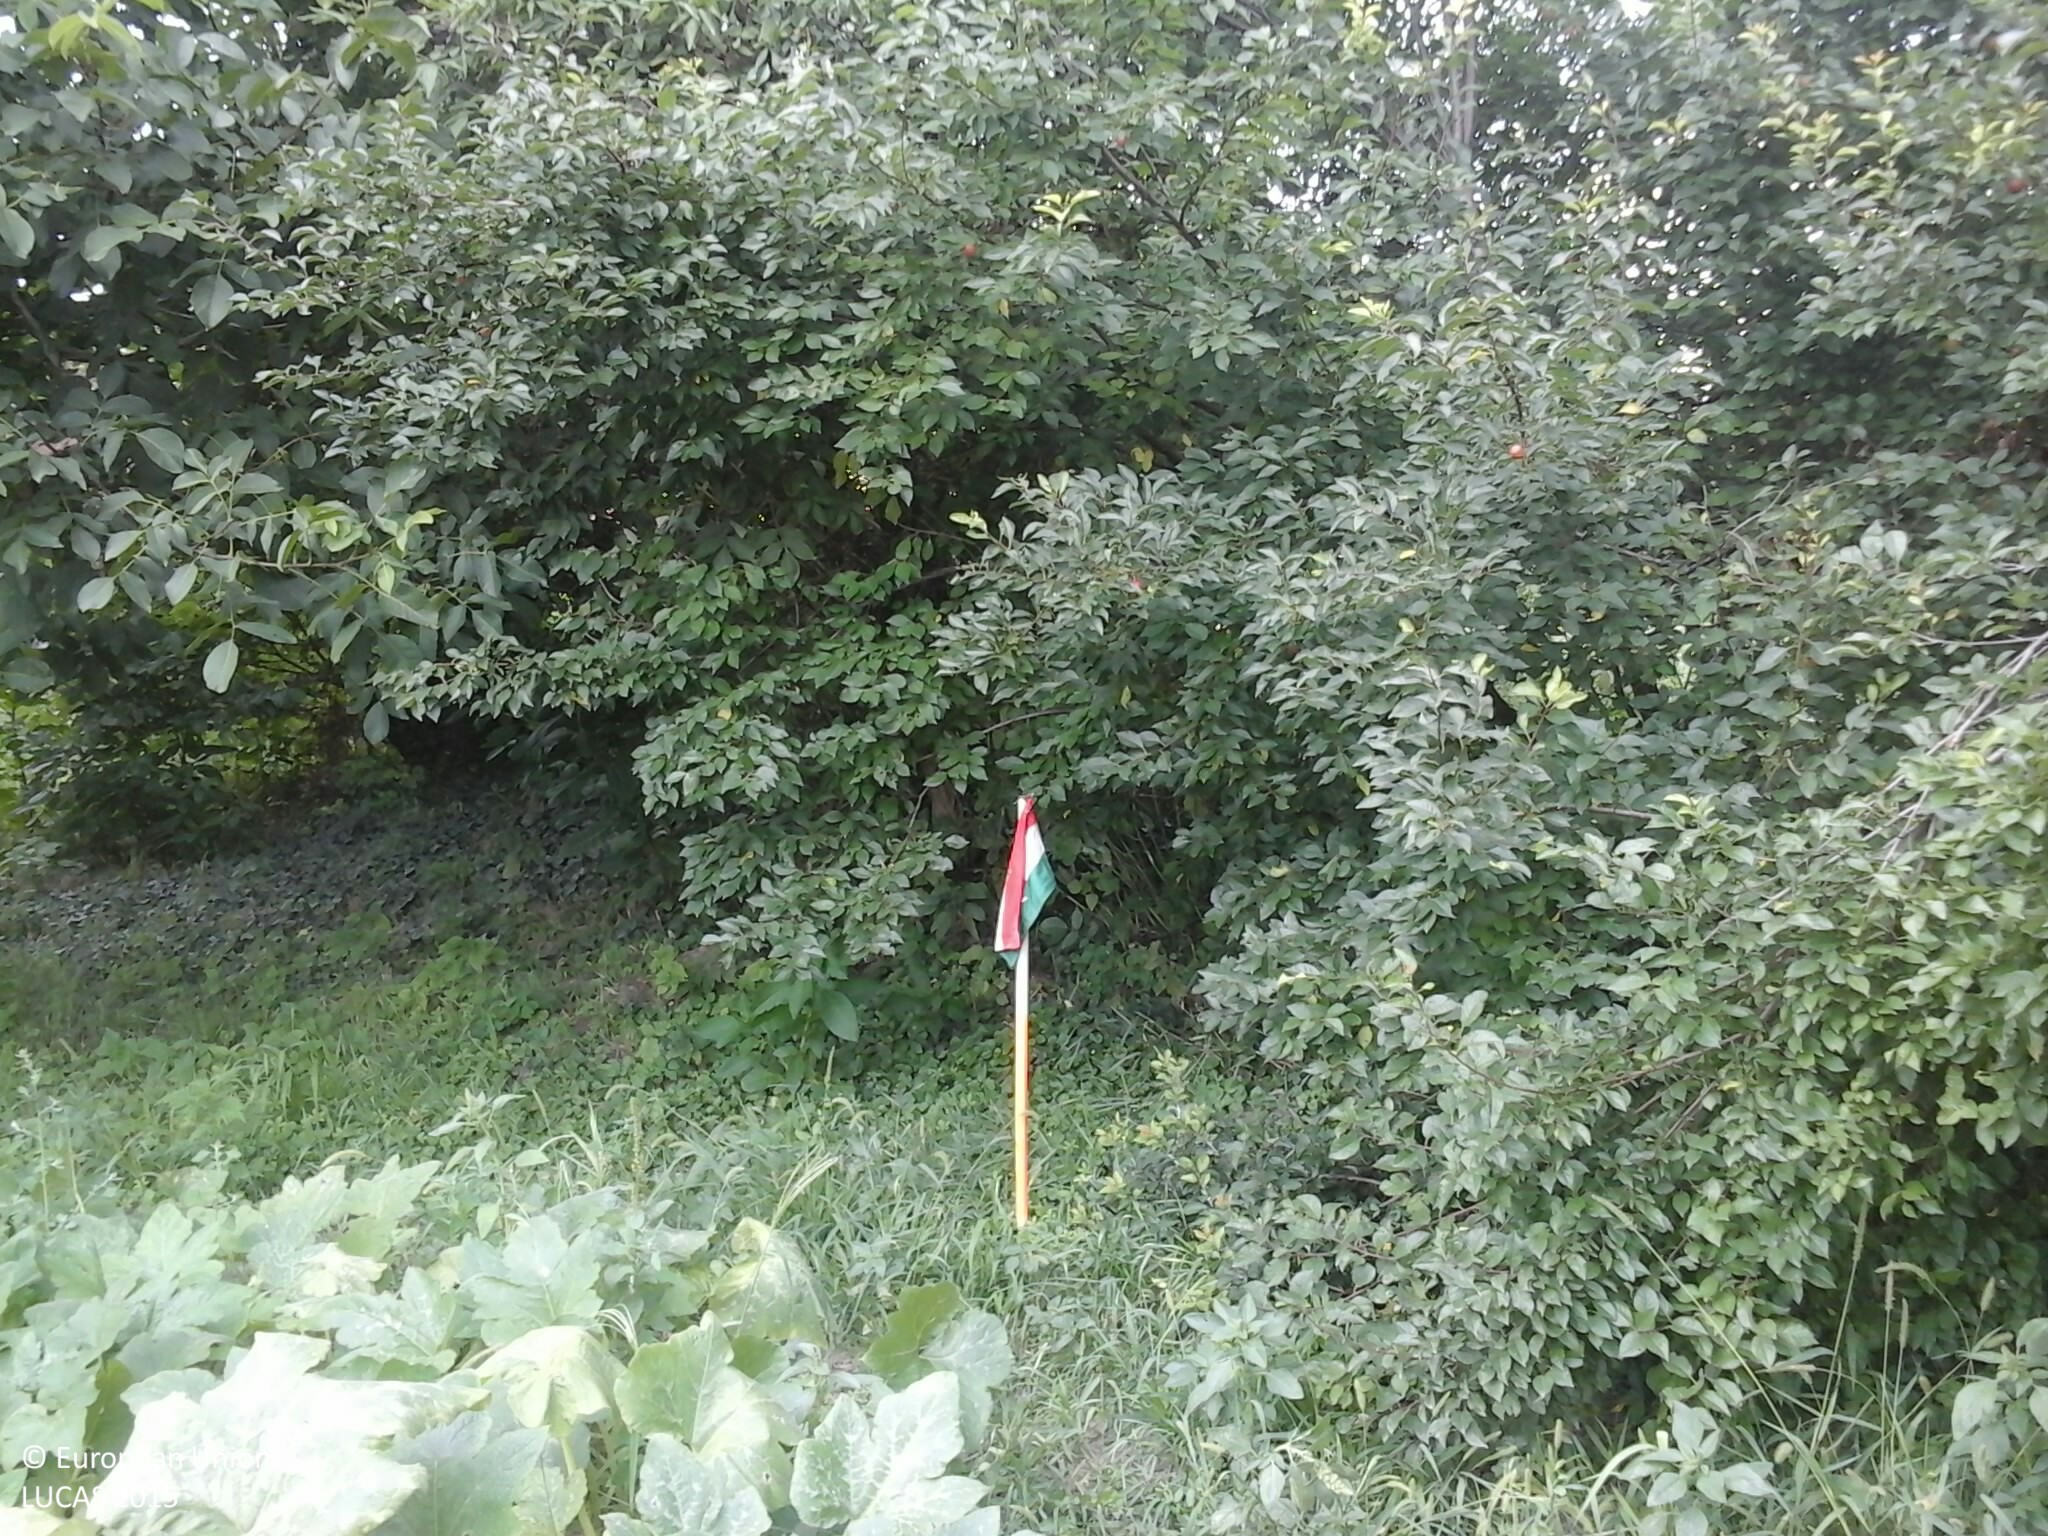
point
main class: Cropland
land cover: Other fruit trees and berries
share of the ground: 25 - 50 %
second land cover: Grassland without tree/shrub cover
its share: 25 - 50 %
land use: Kitchen garden
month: August
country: HU
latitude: 45.9913
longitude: 18.0750
